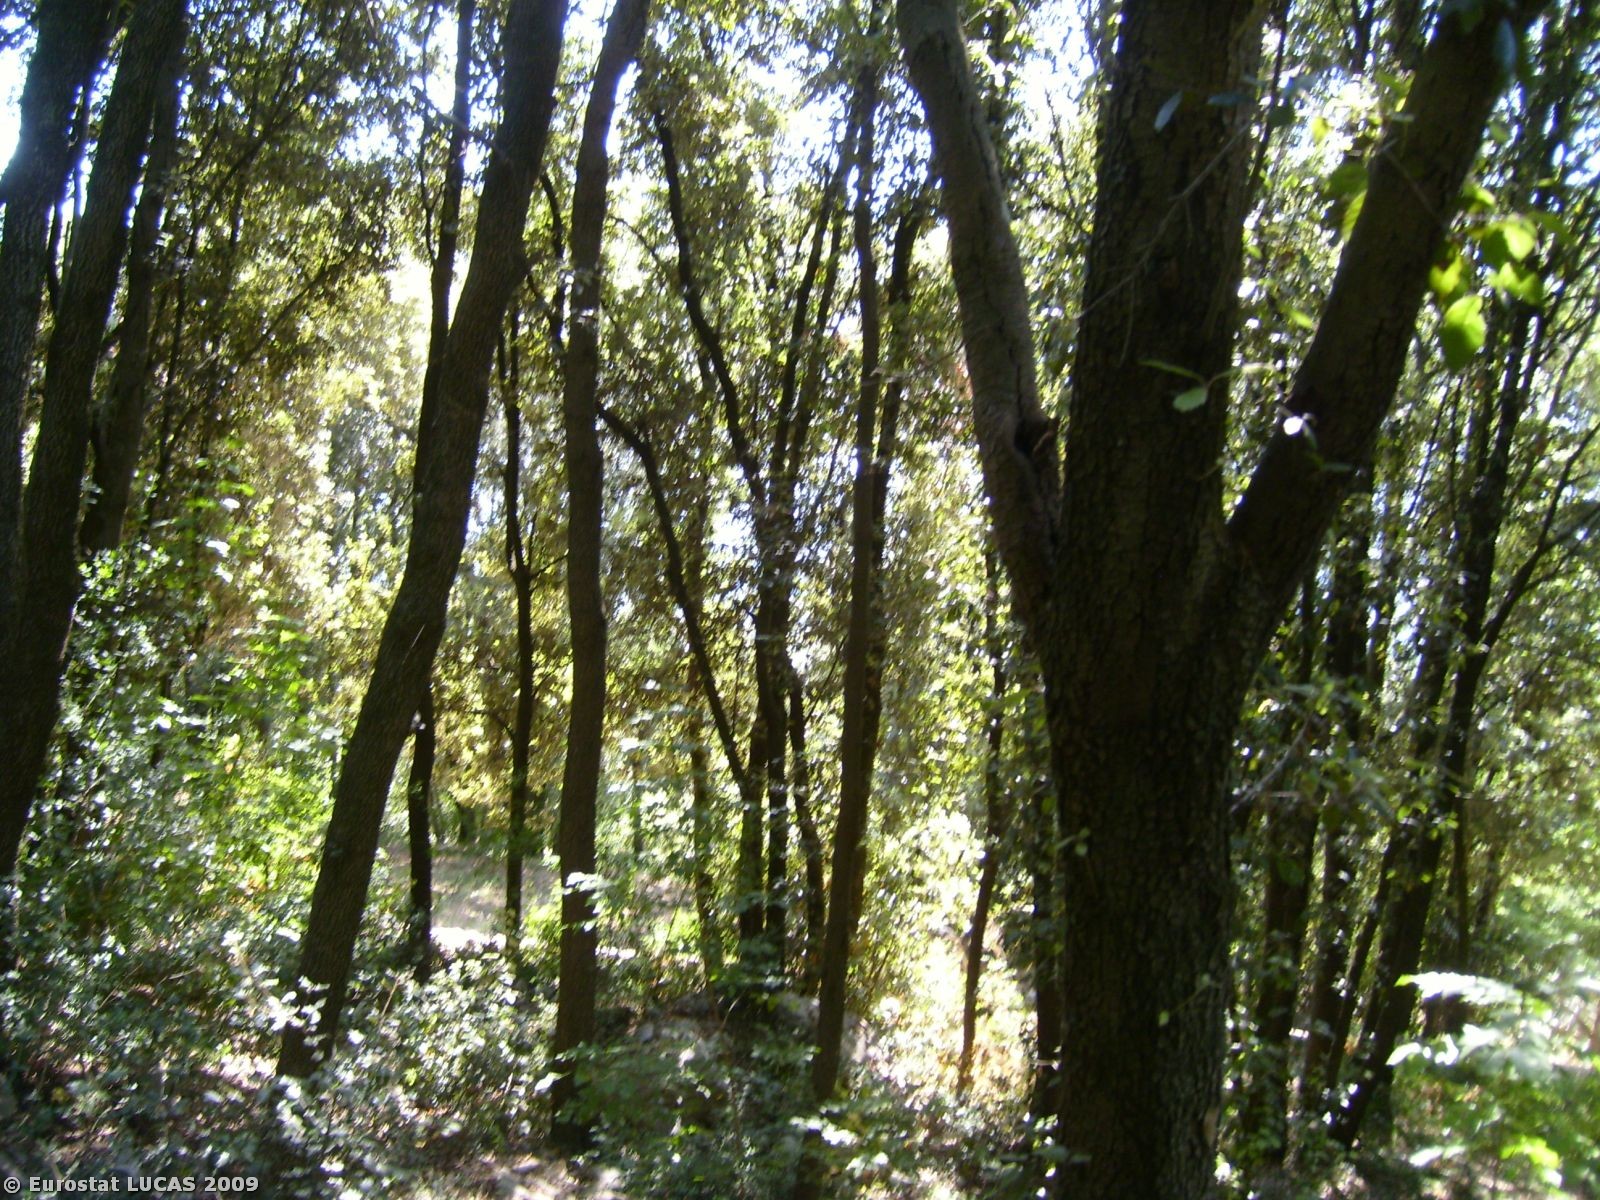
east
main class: Woodland
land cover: Broadleaved woodland
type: thermophilous deciduous forest
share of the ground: > 75 %
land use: Forestry
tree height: > 5 m
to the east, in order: Broadleaved woodland; Fences; Broadleaved woodland; Artificial constructions; Paved roads, cycling and walking lanes; Broadleaved woodland; Electric lines; Grass margins; Paved roads, cycling and walking lanes; Grass margins; Dry stone walls; Olive groves; Spontaneously vegetated surfaces
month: July
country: IT
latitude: 41.2221
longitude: 14.3372
